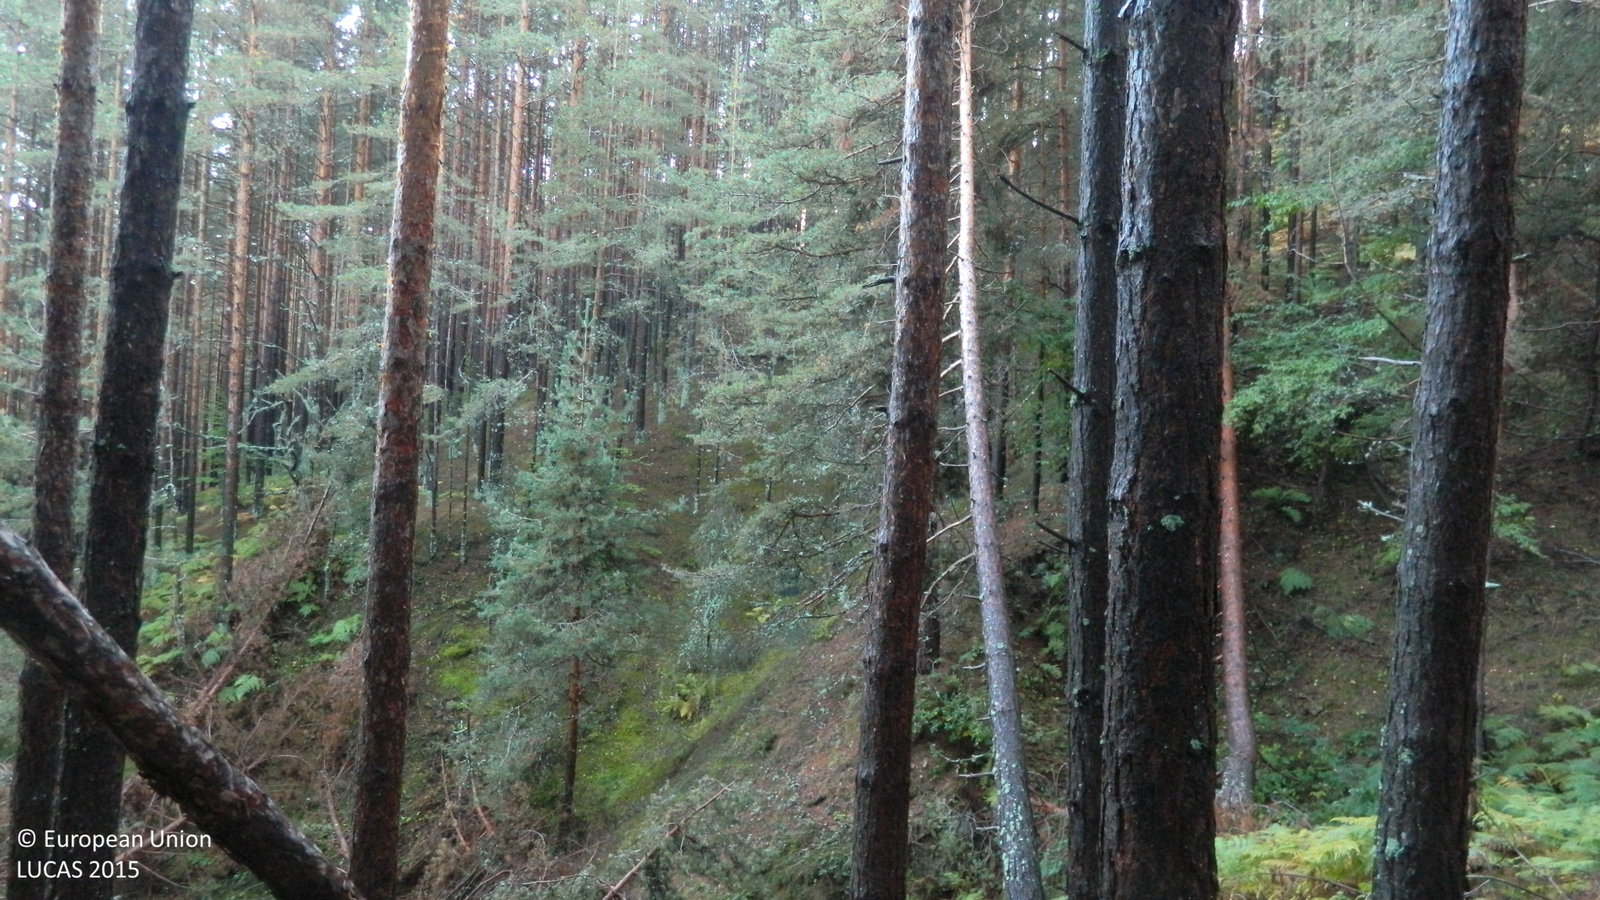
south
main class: Woodland
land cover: Pine dominated coniferous woodland
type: alpine coniferous forest
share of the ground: > 75 %
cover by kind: coniferous forest trees 95 %, herbaceous plants 5 %
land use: Forestry
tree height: > 5 m
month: October
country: BG
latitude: 41.6968
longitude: 24.9861
